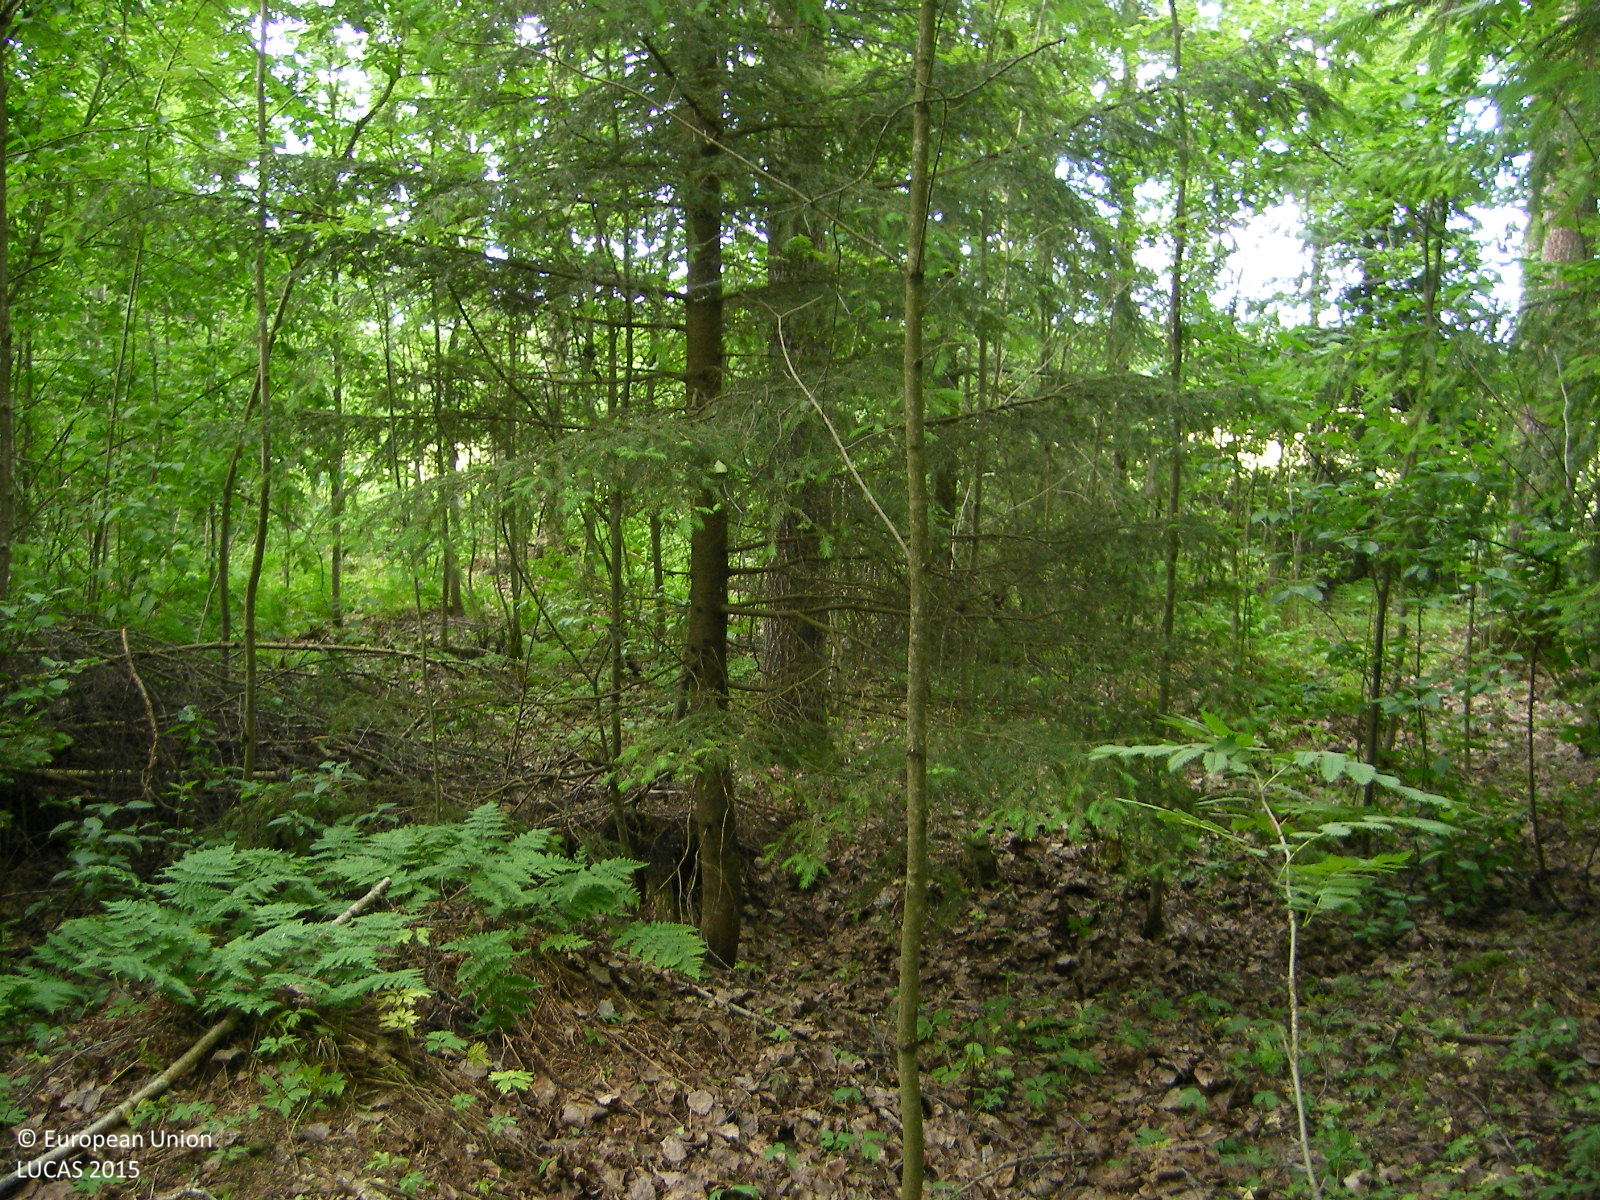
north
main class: Woodland
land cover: Other mixed woodland
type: hemiboreal forest and nemoral coniferous forest and mixed broadleaved-coniferous forest
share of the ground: > 75 %
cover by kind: broadleaved forest trees 70 %, coniferous forest trees 25 %, herbaceous plants 5 %
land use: Forestry
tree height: > 5 m
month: June
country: FI
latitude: 60.3187
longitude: 23.8355
